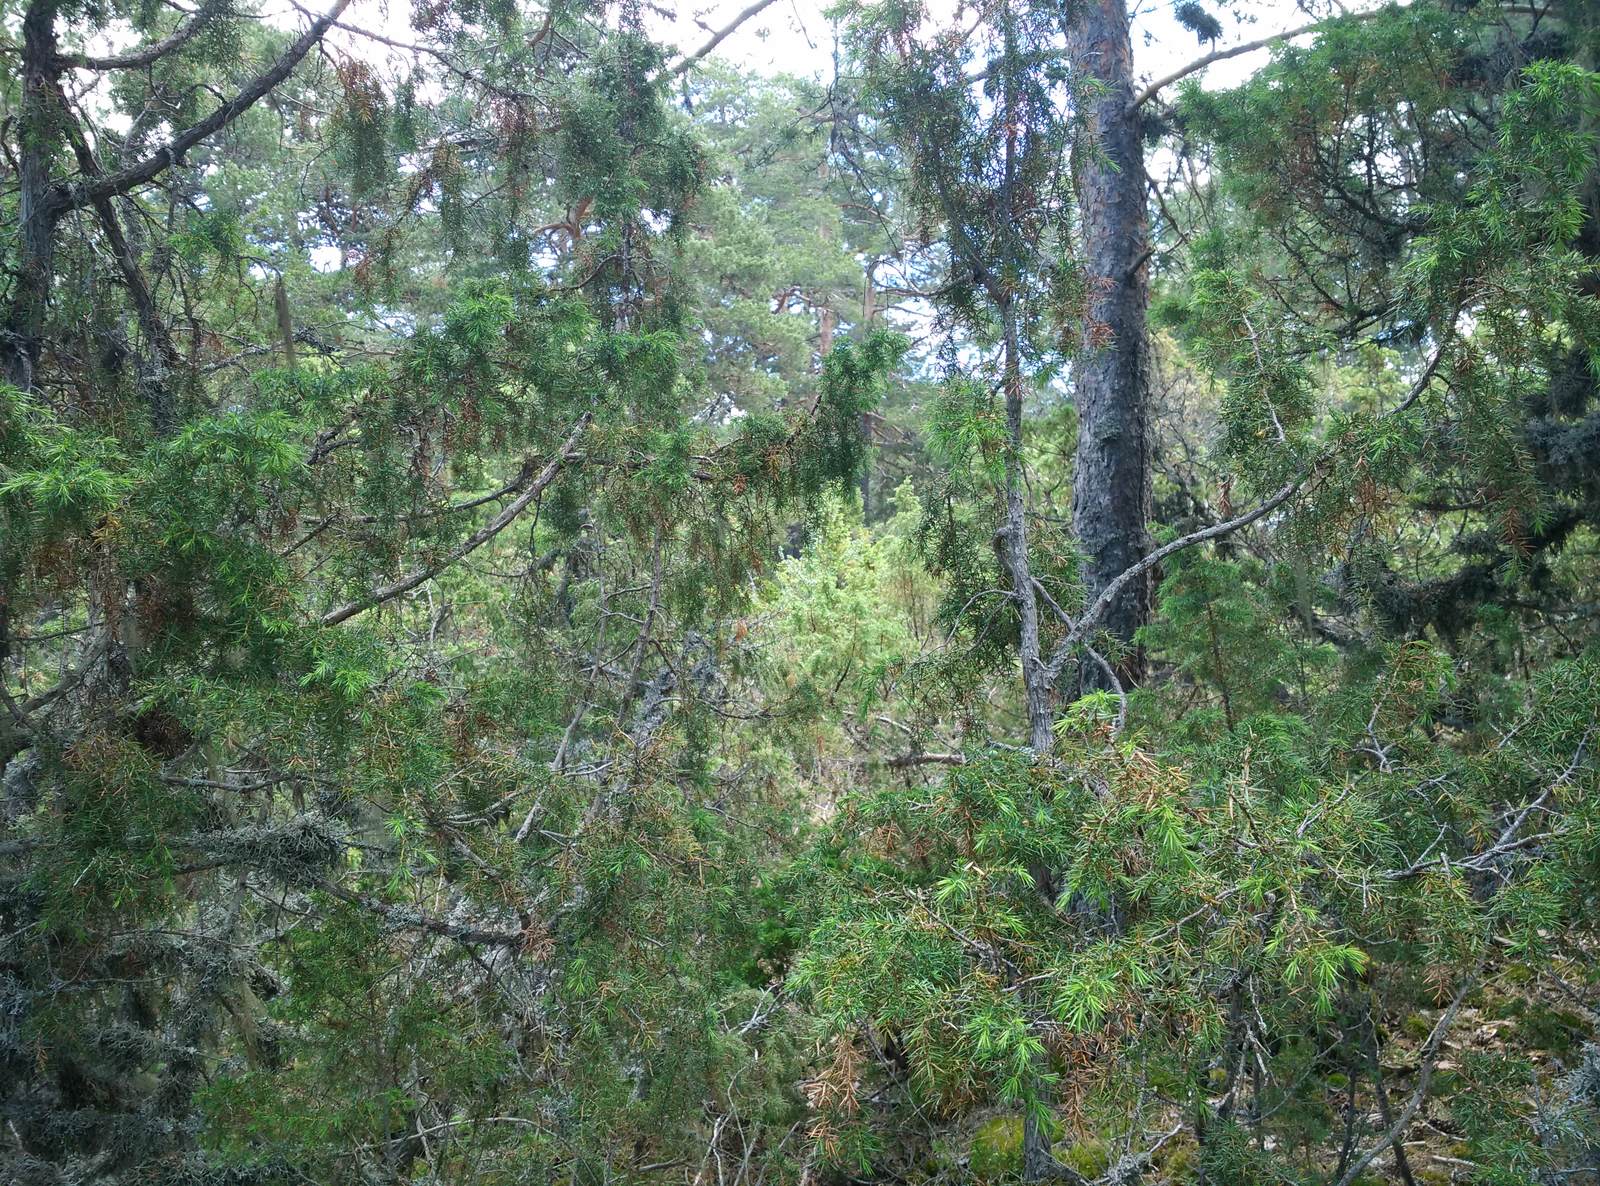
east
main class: Woodland
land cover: Pine dominated coniferous woodland
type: coniferous forest of the mediterranean region
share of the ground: 10 - 25 %
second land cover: Shrubland without tree cover
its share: 10 - 25 %
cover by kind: unconsolidated bare surface 45 %, coniferous forest trees 20 %, shrubs 20 %, herbaceous plants 10 %, lichens and mosses 5 %
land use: Forestry
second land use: Agriculture (excluding fallow land and kitchen gardens)
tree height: > 5 m
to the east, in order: Pine dominated coniferous woodland; Shrubland without tree cover; Pine dominated coniferous woodland
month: June
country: ES
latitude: 40.4591
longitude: -1.7029
